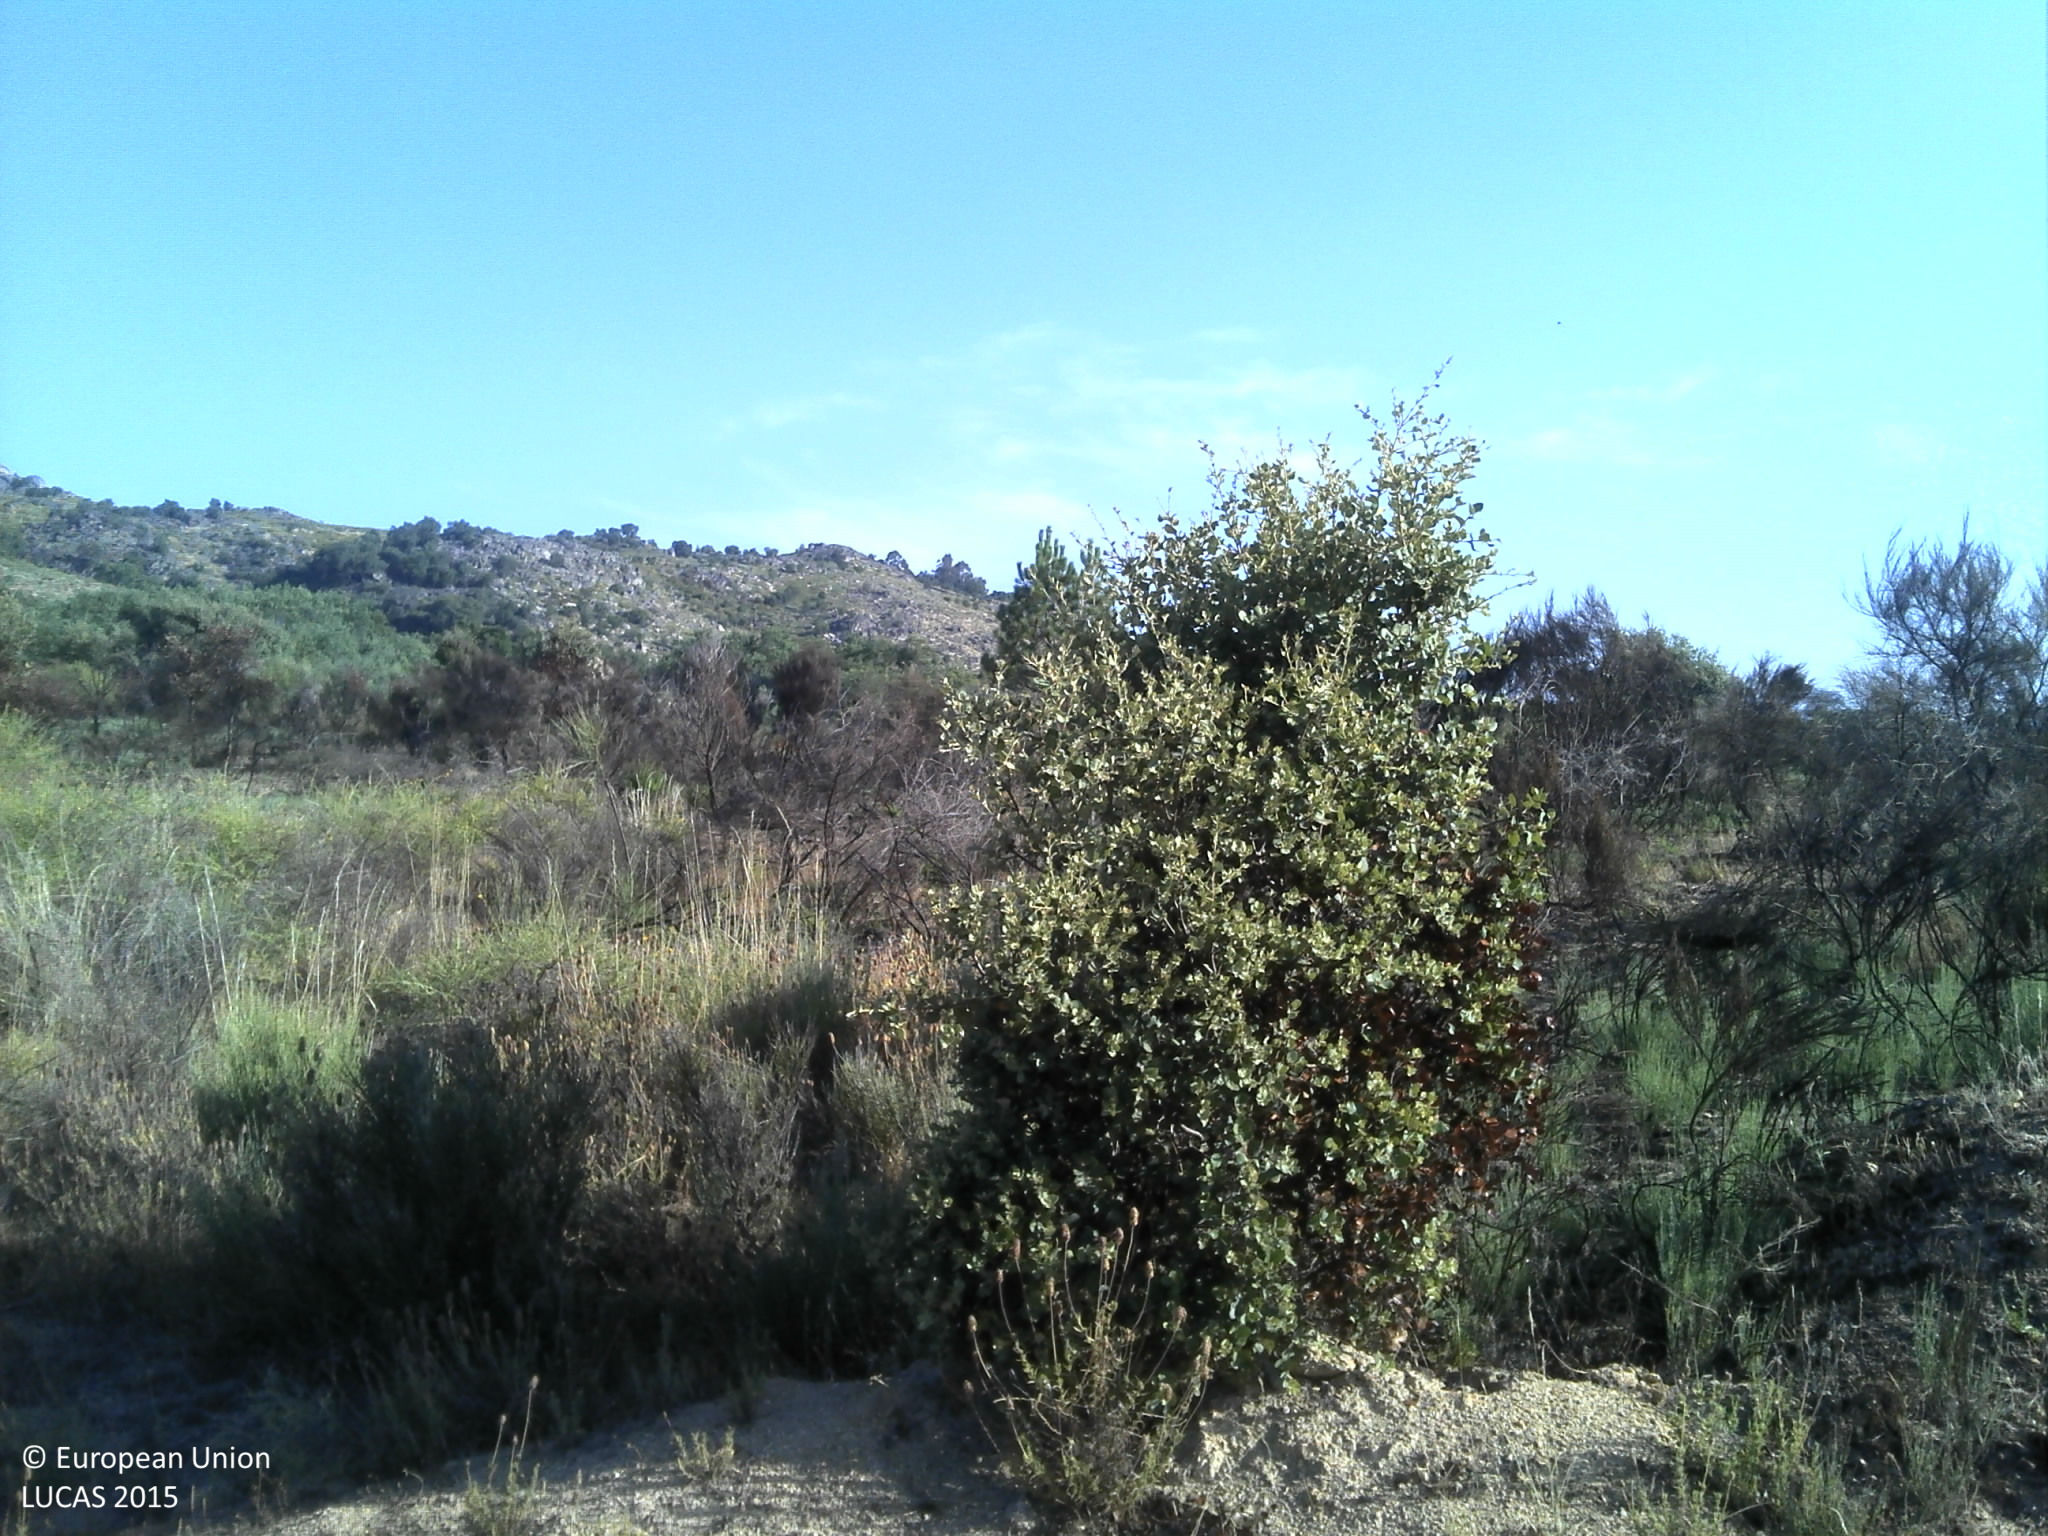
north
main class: Shrubland
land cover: Shrubland without tree cover
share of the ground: 50 - 75 %
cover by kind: shrubs 50 %, herbaceous plants 35 %, unconsolidated bare surface 10 %
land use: Forestry
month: June
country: PT
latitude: 40.0268
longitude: -7.0957
